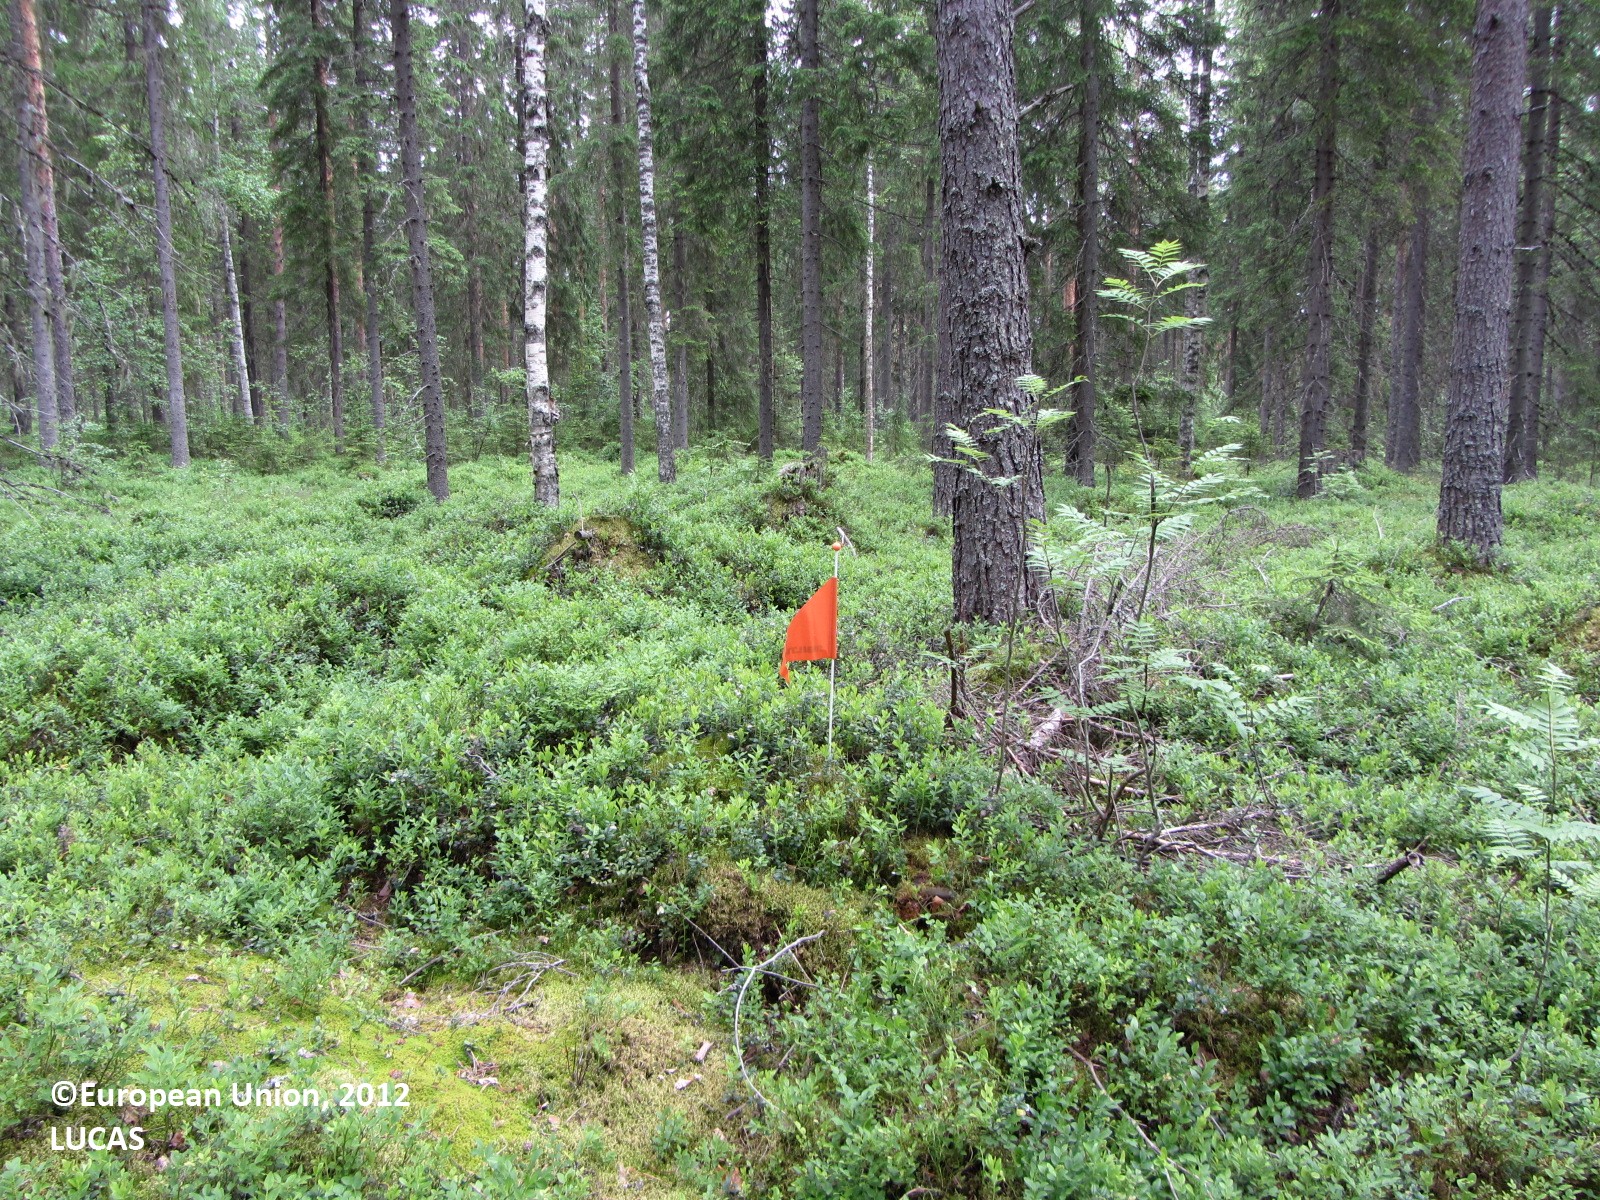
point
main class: Woodland
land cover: Spruce dominated mixed woodland
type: boreal forest
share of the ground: 50 - 75 %
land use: Forestry
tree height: > 5 m
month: June
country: FI
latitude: 62.5864
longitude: 25.2320
